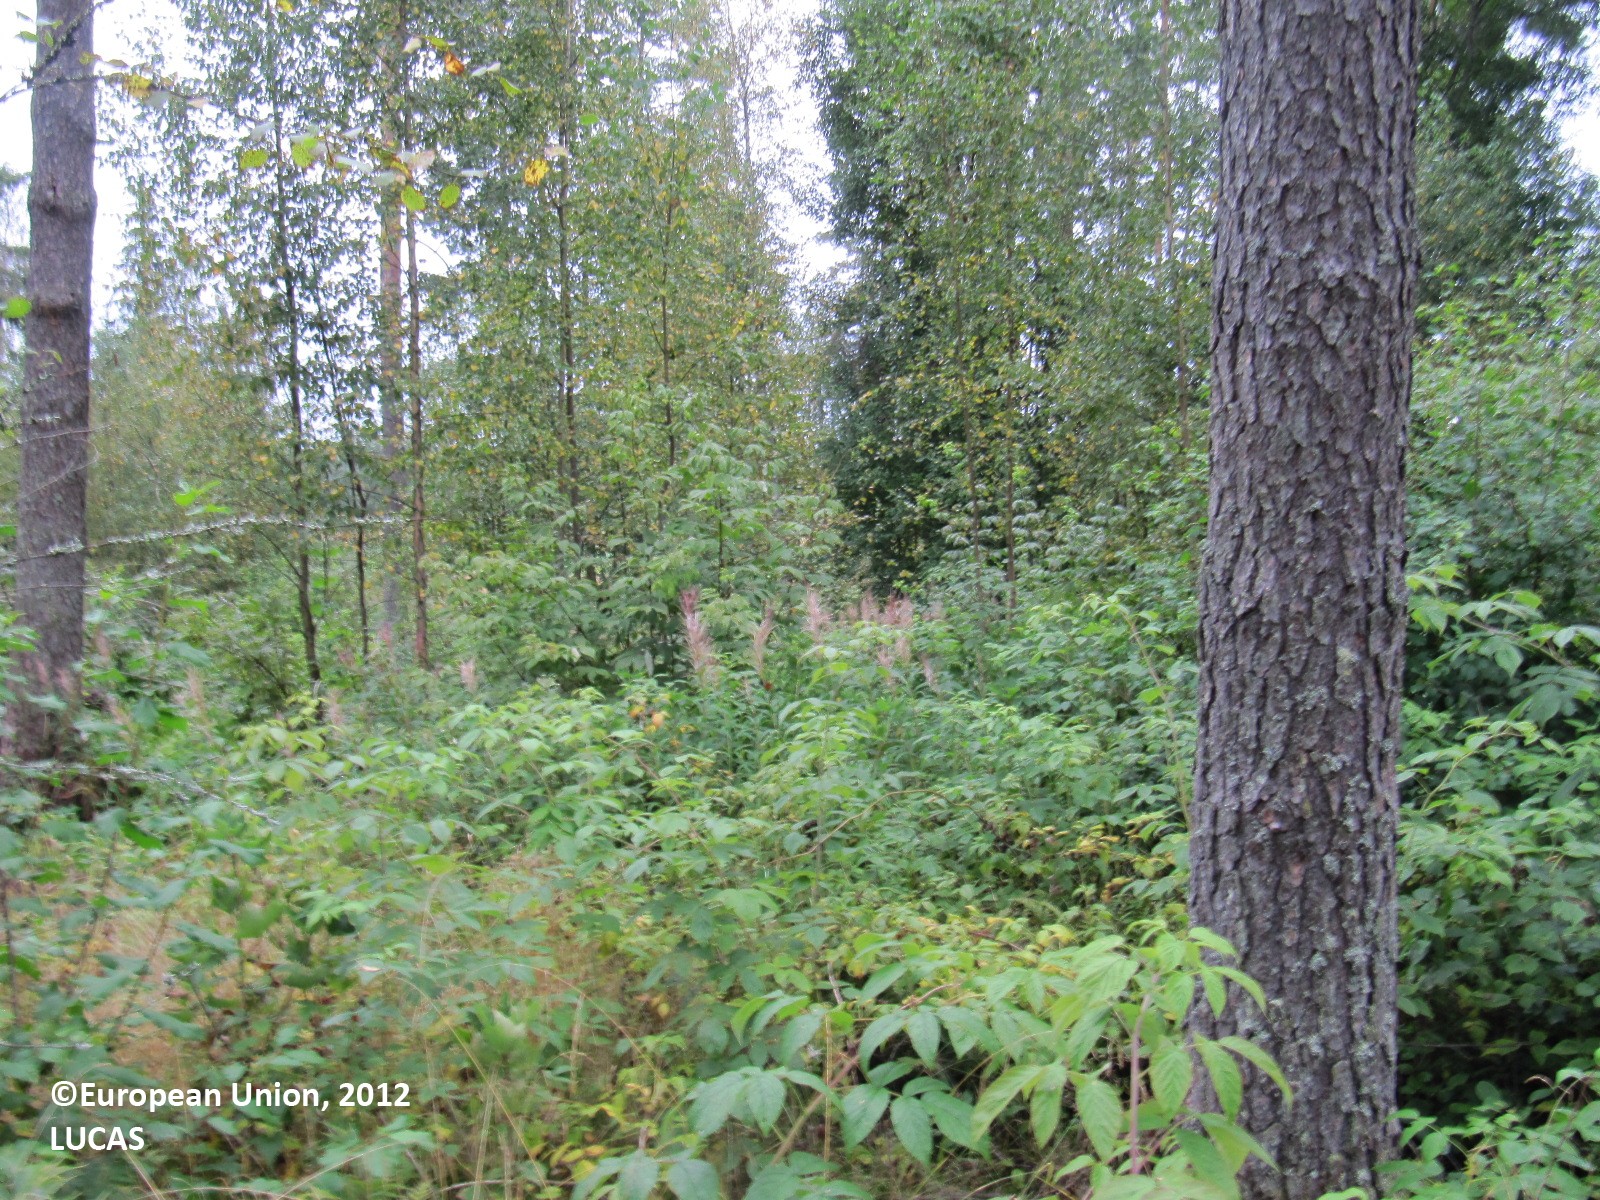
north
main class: Woodland
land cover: Pine dominated mixed woodland
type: boreal forest
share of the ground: 25 - 50 %
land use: Forestry
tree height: > 5 m
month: August
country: FI
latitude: 61.0393
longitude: 23.3923
